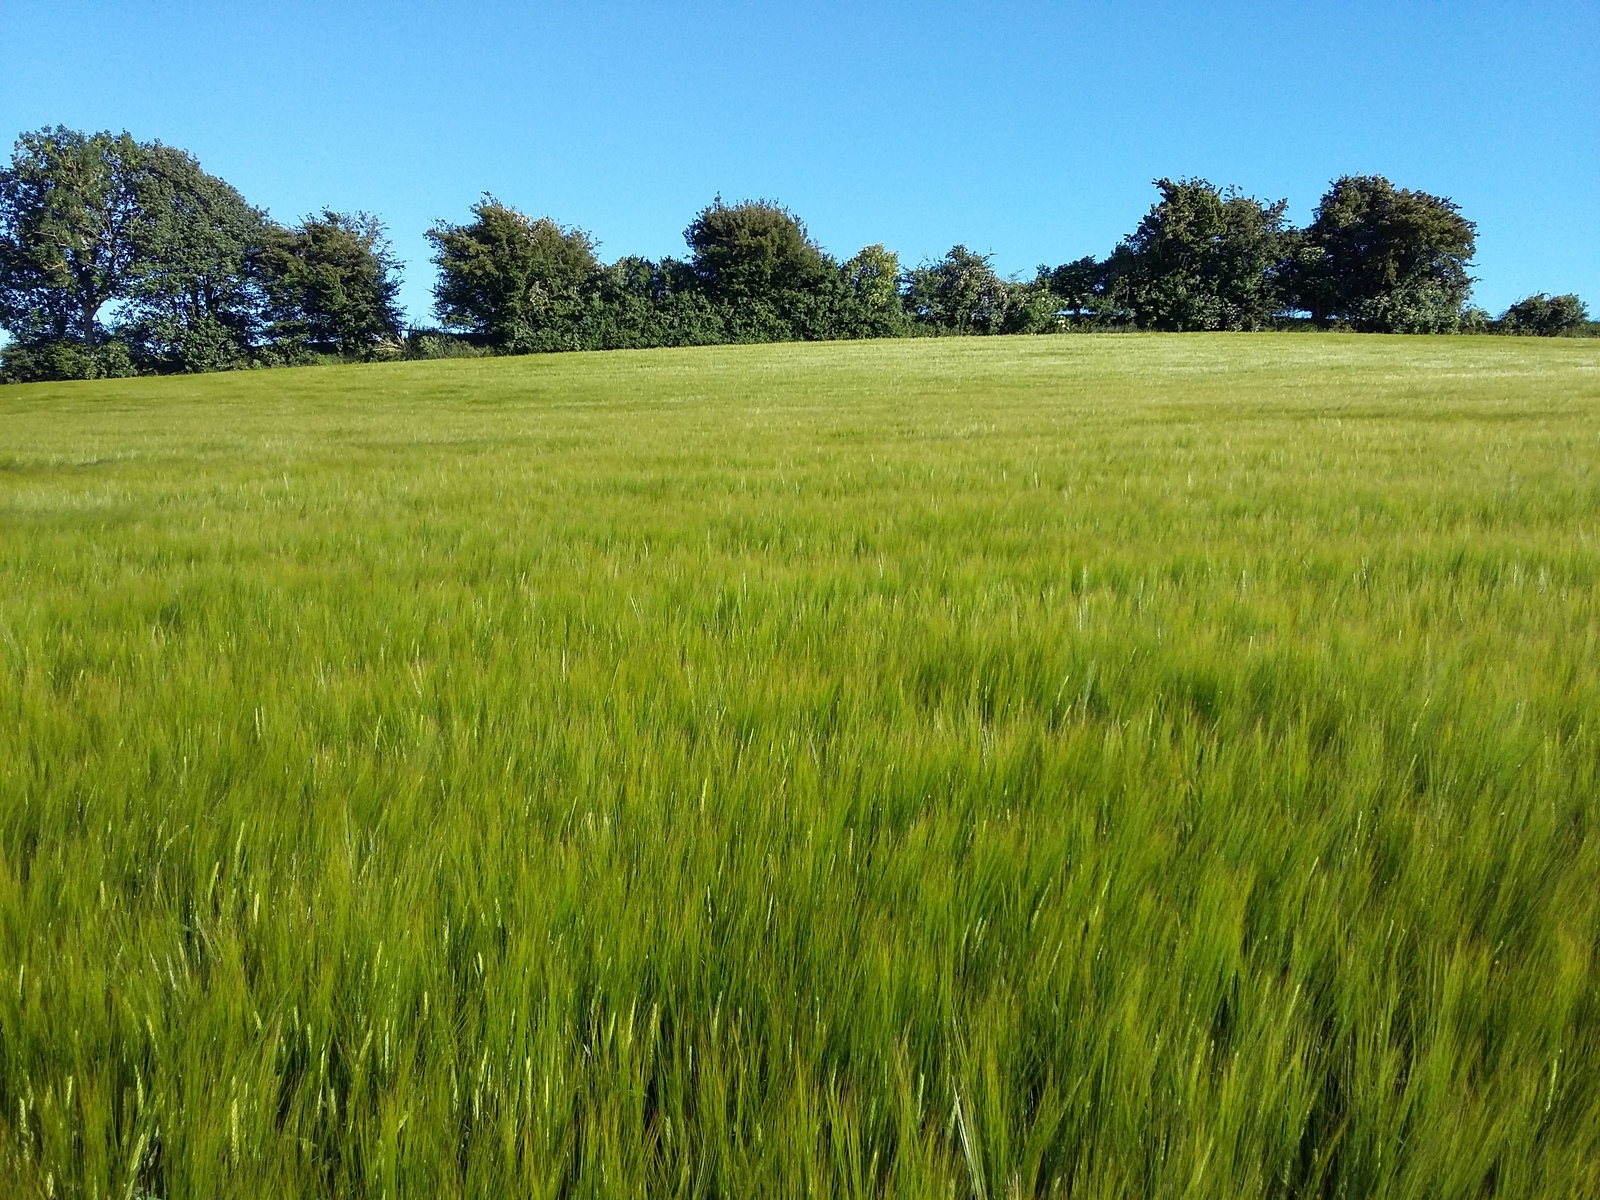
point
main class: Cropland
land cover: Barley
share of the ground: > 75 %
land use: Agriculture (excluding fallow land and kitchen gardens)
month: July
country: DK
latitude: 55.0196
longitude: 12.1101
